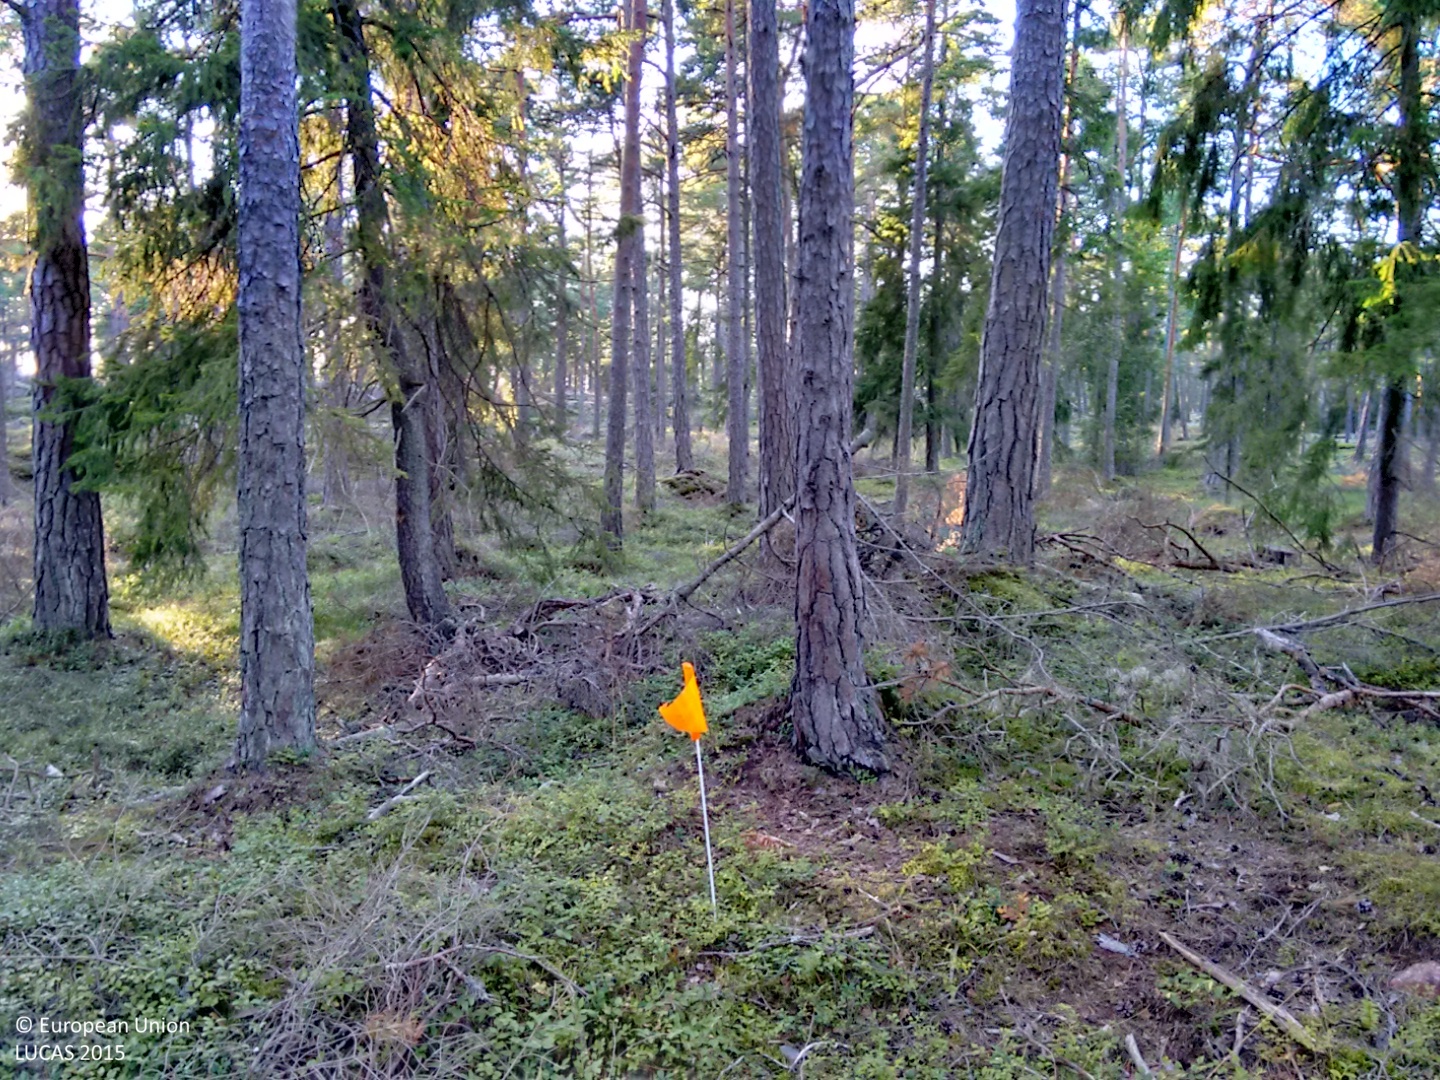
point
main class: Woodland
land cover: Pine dominated coniferous woodland
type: hemiboreal forest and nemoral coniferous forest and mixed broadleaved-coniferous forest
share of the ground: > 75 %
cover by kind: coniferous forest trees 90 %, shrubs 10 %
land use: Forestry
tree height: > 5 m
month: August
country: FI
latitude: 60.1157
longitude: 19.9934
